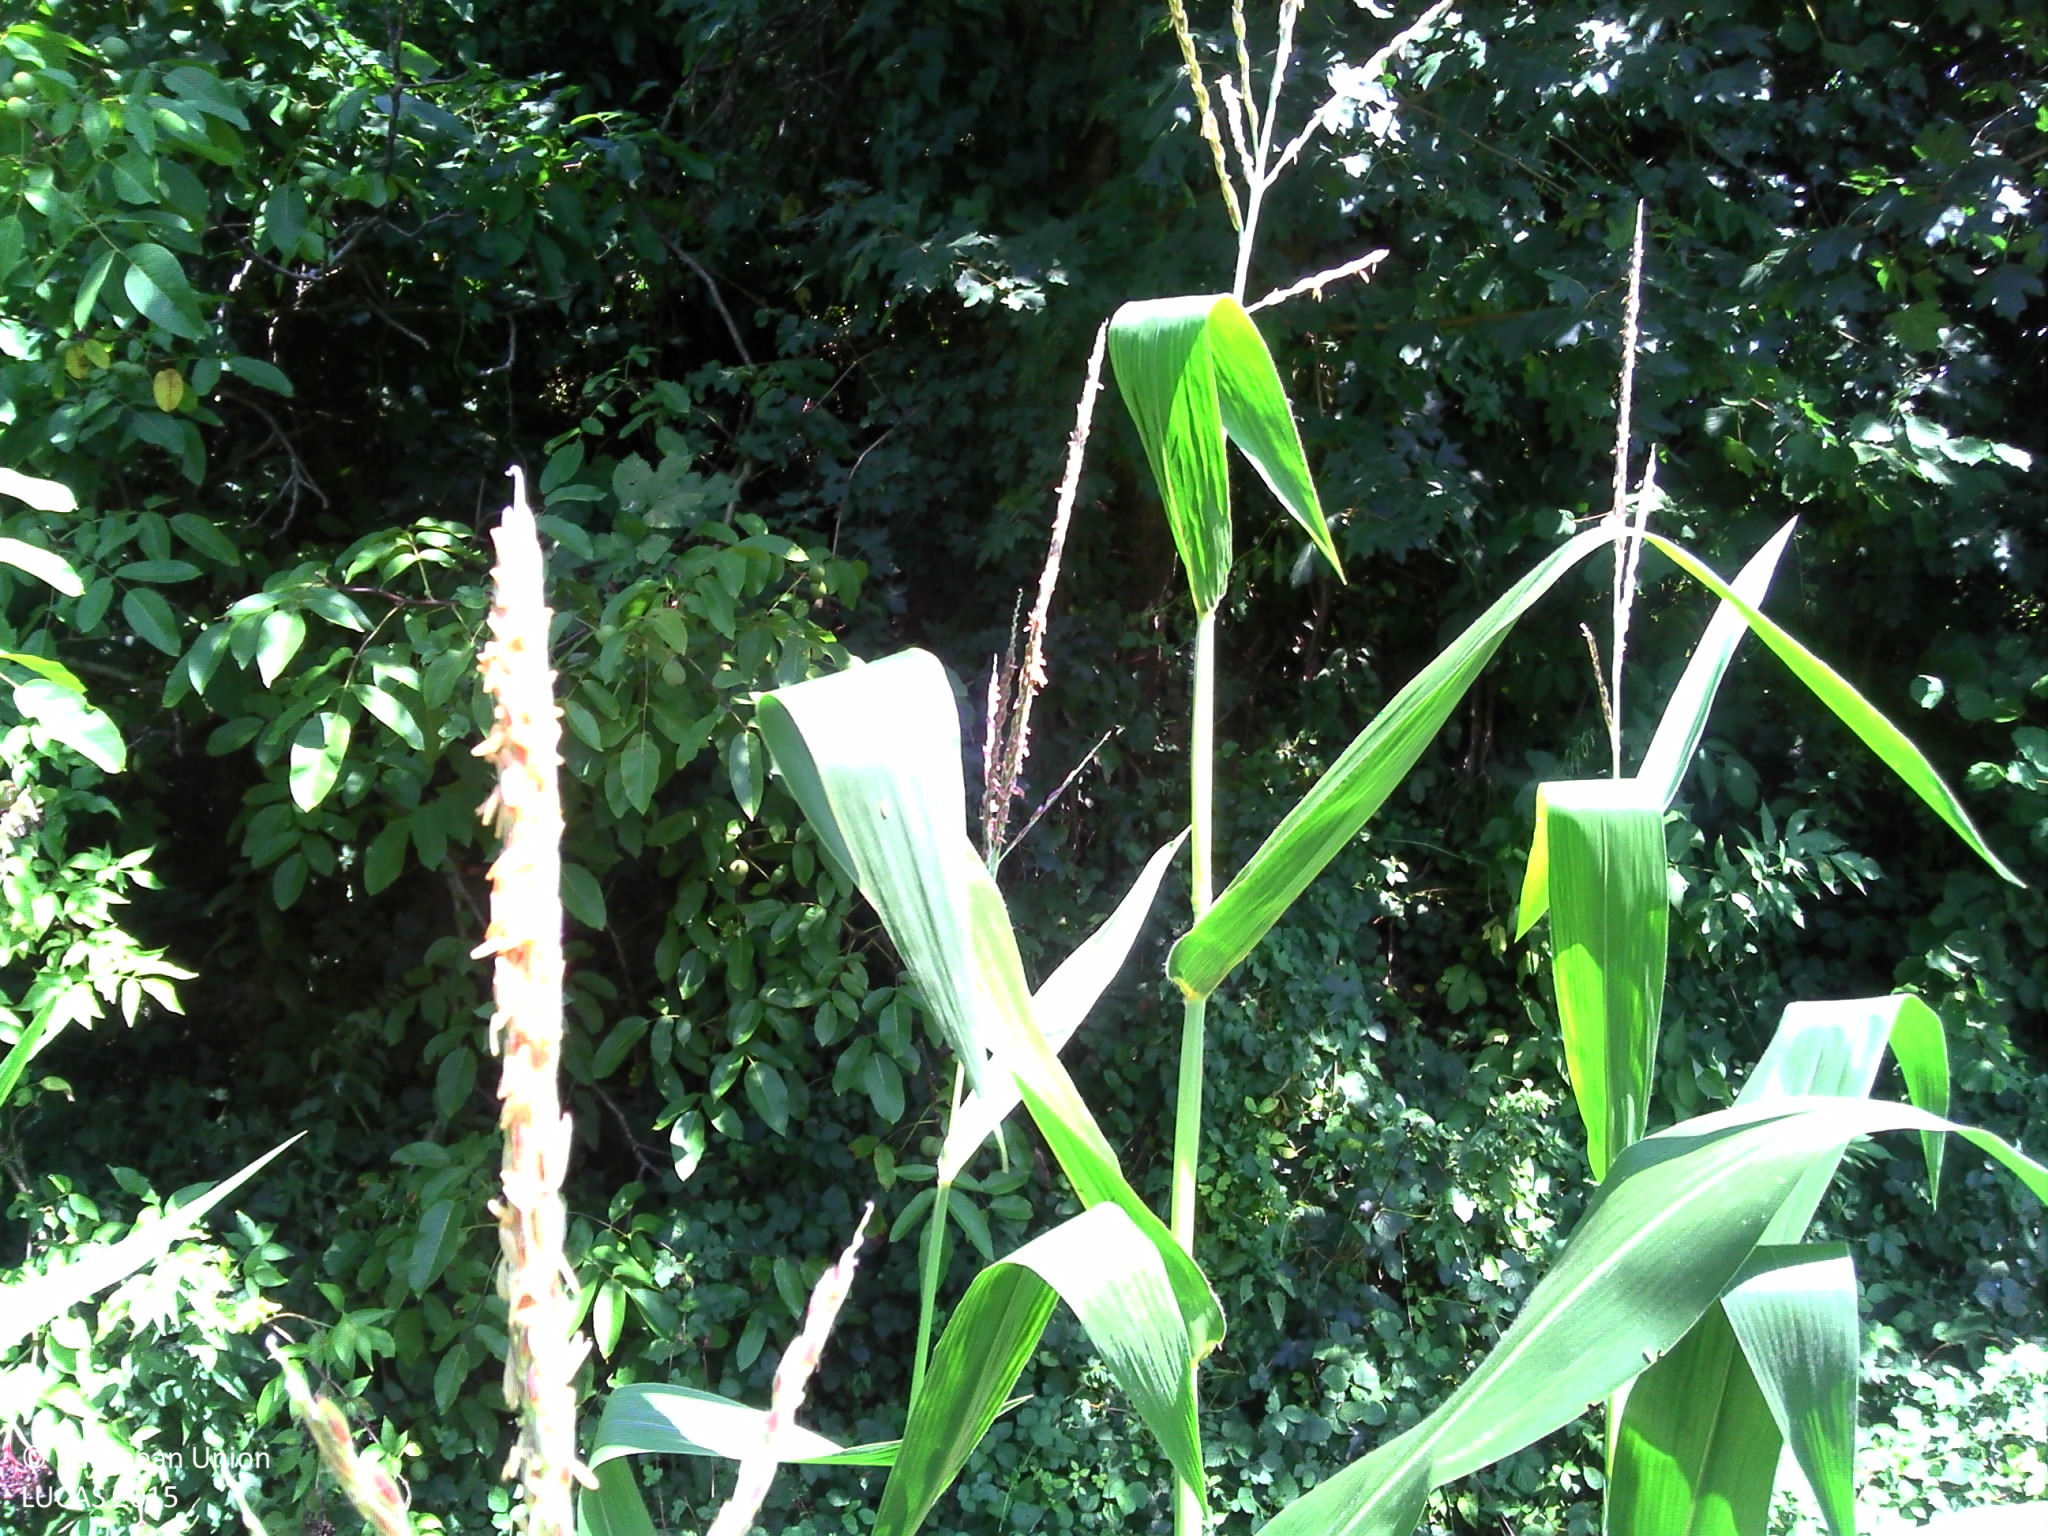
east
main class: Cropland
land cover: Maize
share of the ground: > 75 %
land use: Agriculture (excluding fallow land and kitchen gardens)
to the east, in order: Maize; Broadleaved woodland; Shrubland with sparse tree cover; Broadleaved woodland; Maize; Electric lines; Spontaneously vegetated surfaces; Other bare soil; Spontaneously vegetated surfaces; Artificial constructions in urban areas
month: August
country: FR
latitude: 43.3220
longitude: -1.0493
